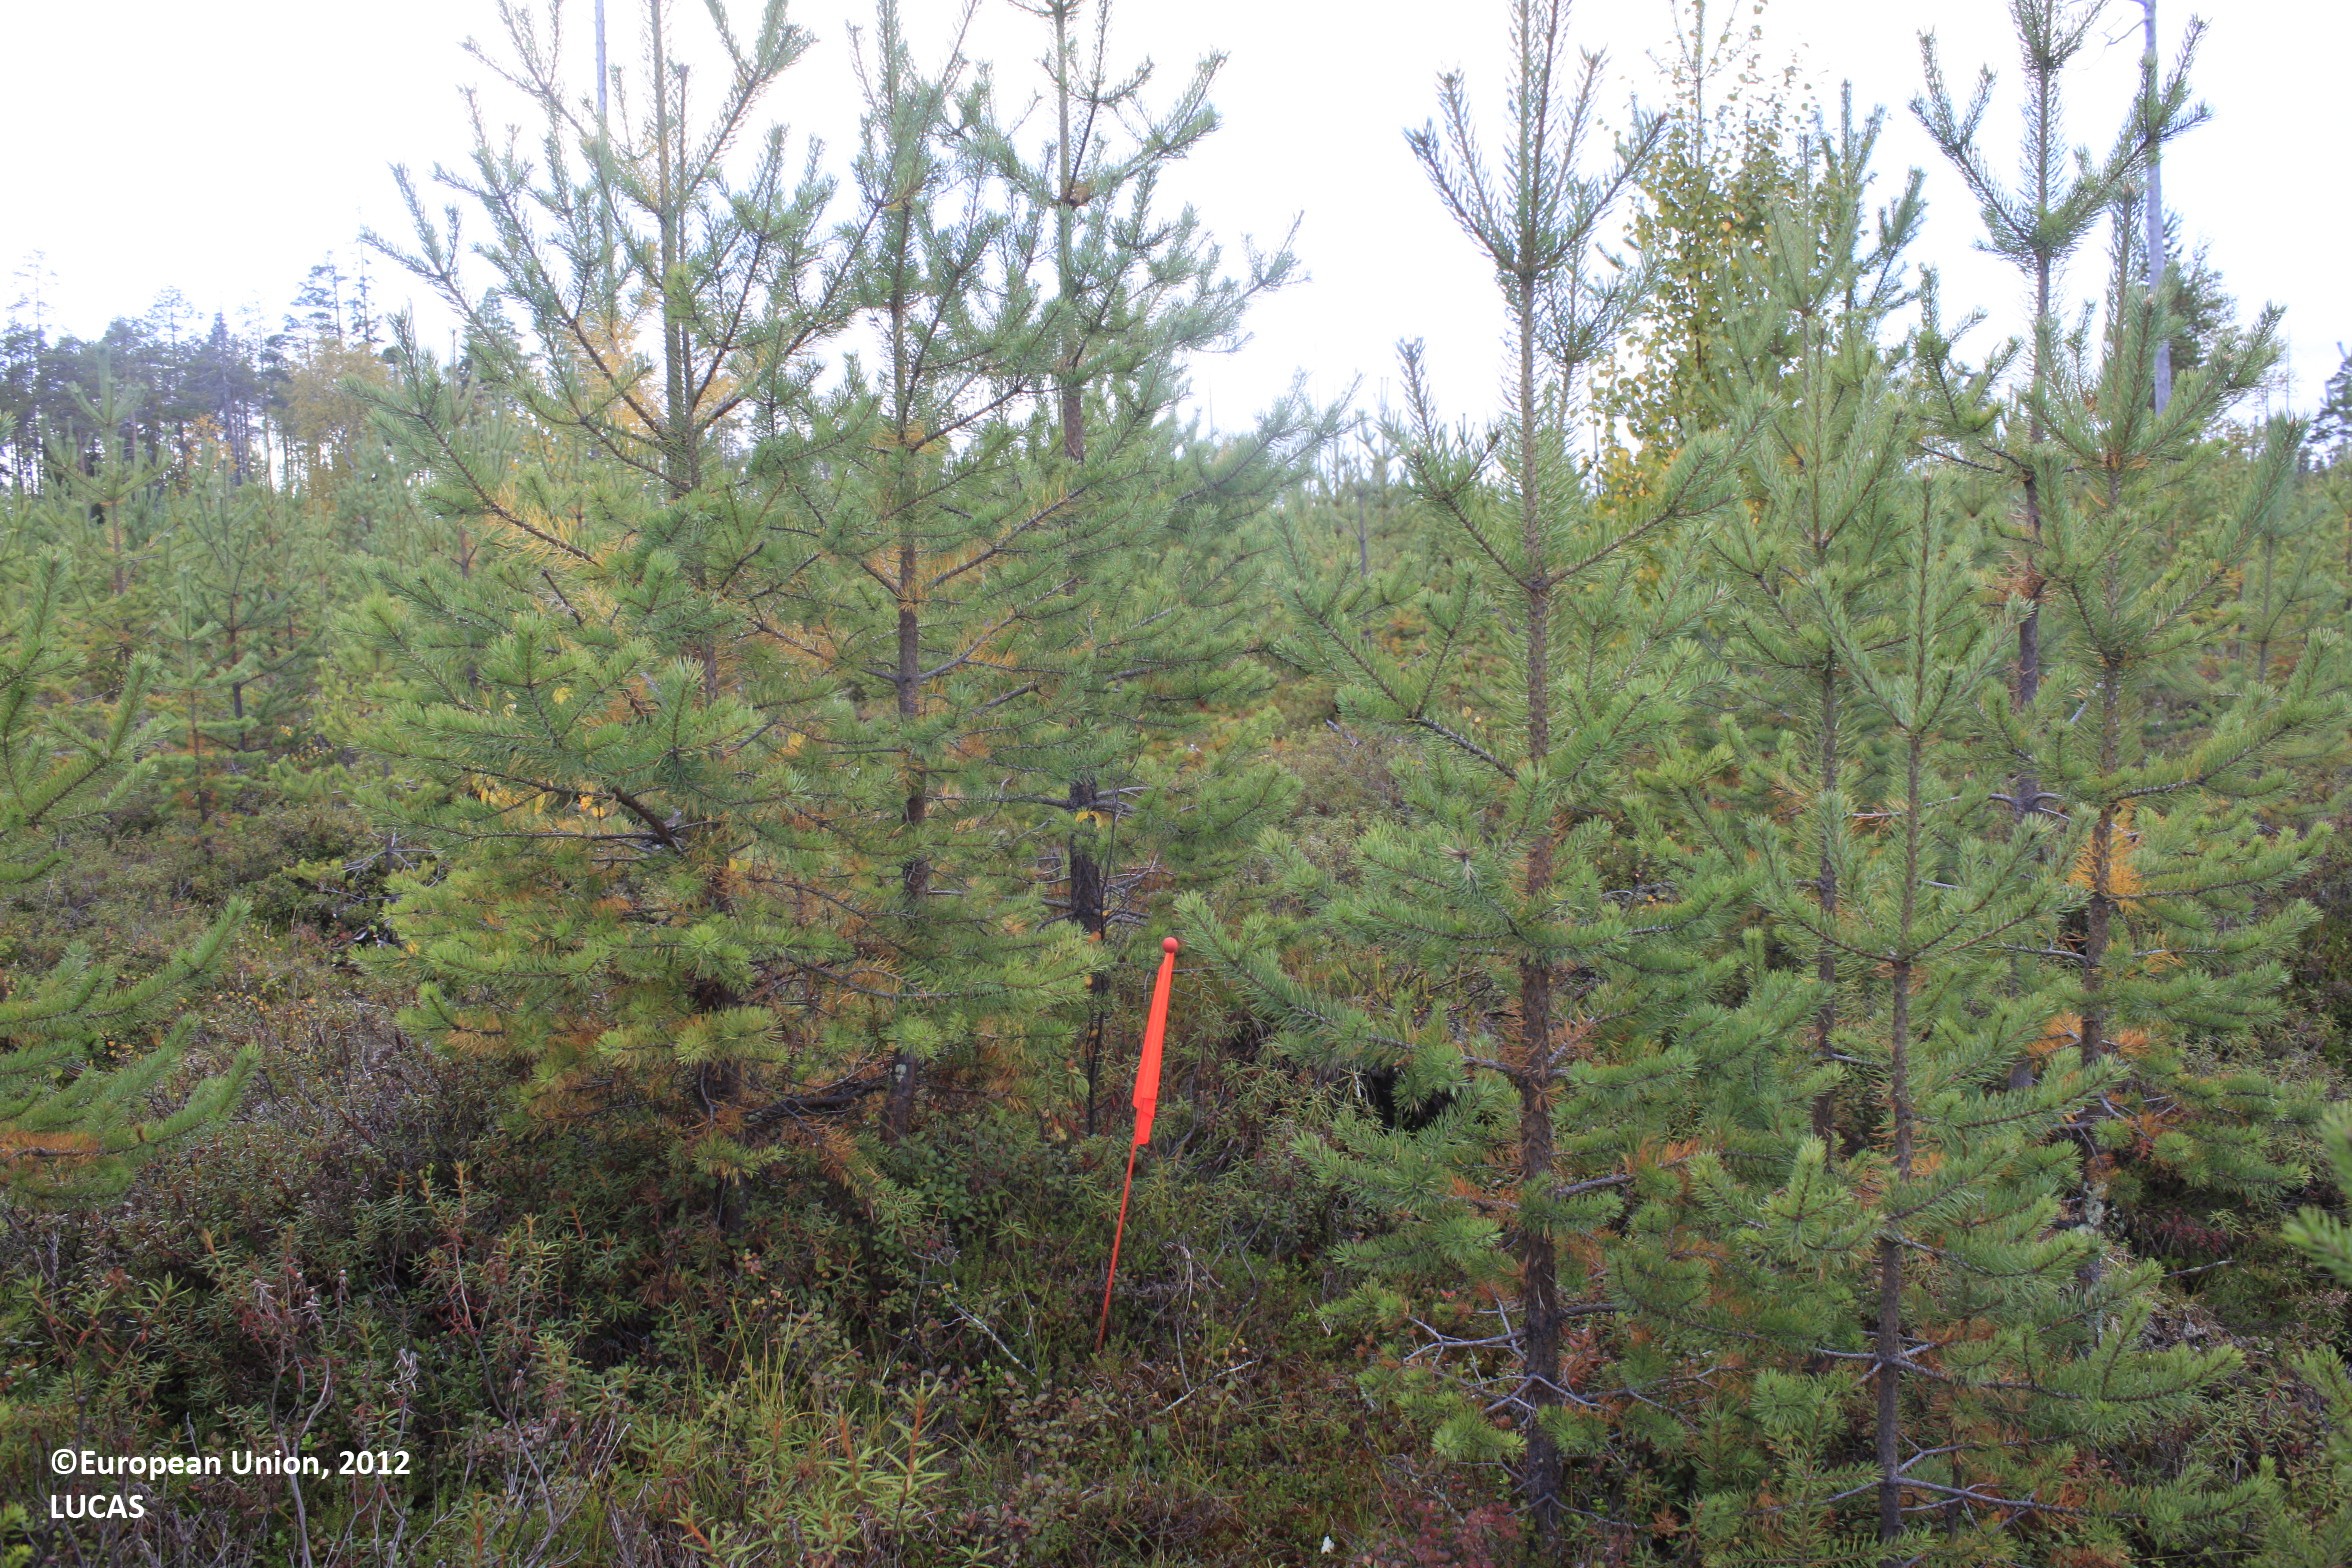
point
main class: Woodland
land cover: Pine dominated coniferous woodland
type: boreal forest
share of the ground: 50 - 75 %
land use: Forestry
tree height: < 5 m
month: September
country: FI
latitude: 65.4320
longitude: 27.0820
